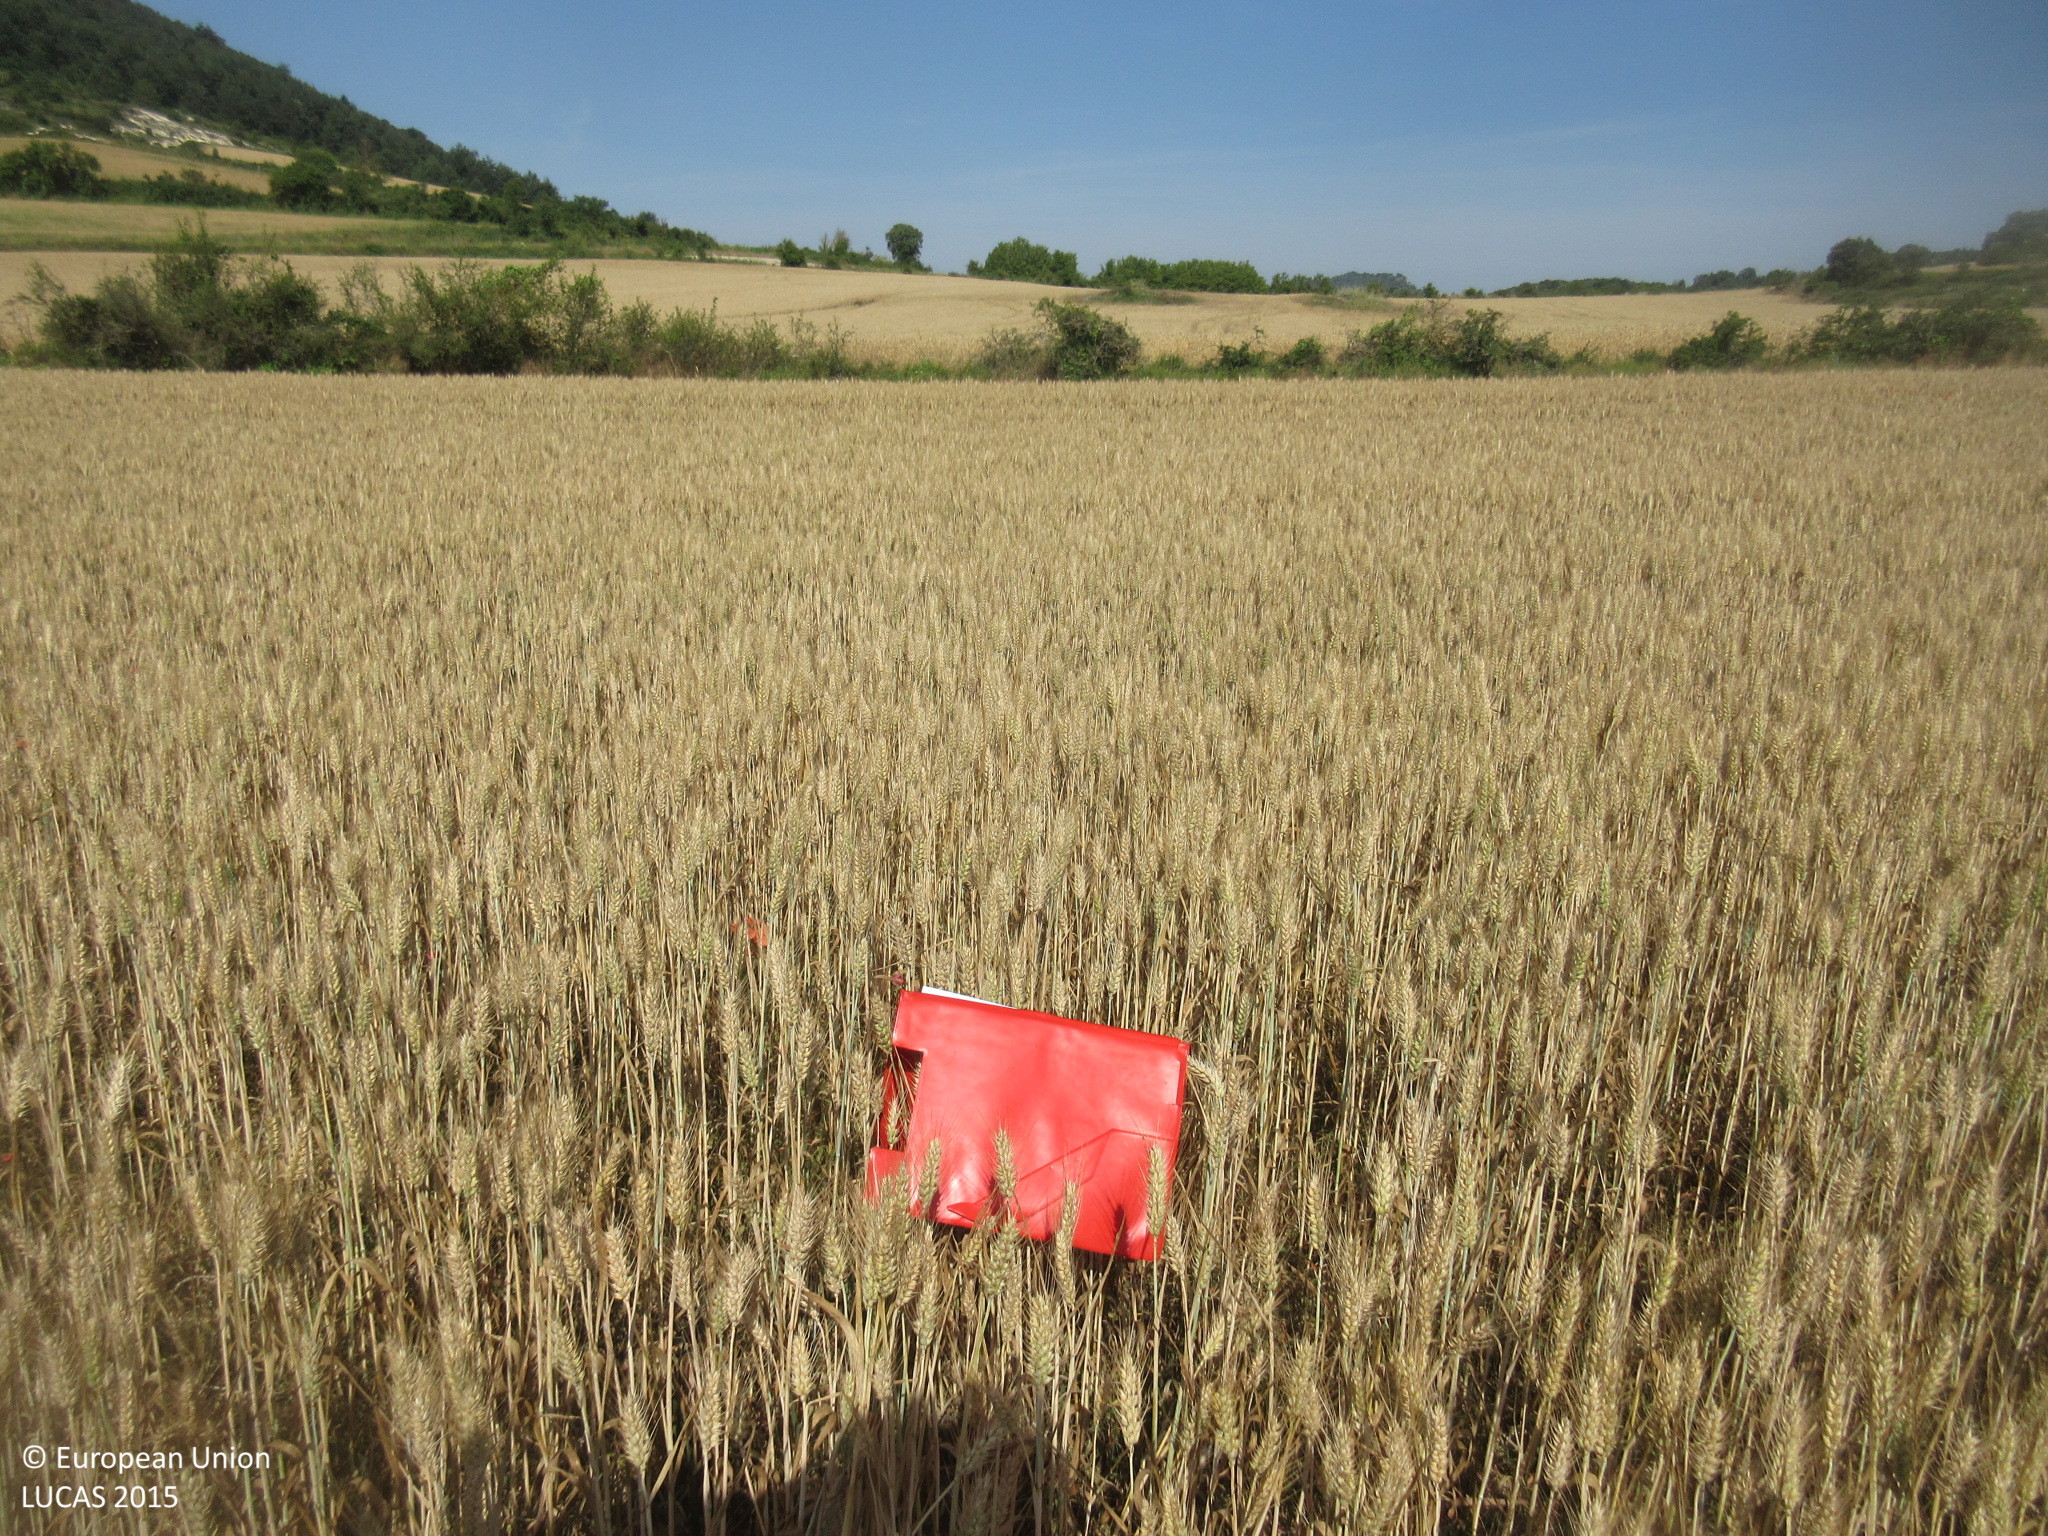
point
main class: Cropland
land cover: Common wheat
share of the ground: > 75 %
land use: Agriculture (excluding fallow land and kitchen gardens)
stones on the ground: 10 - 25 %
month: July
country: ES
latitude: 42.9701
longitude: -3.3650
